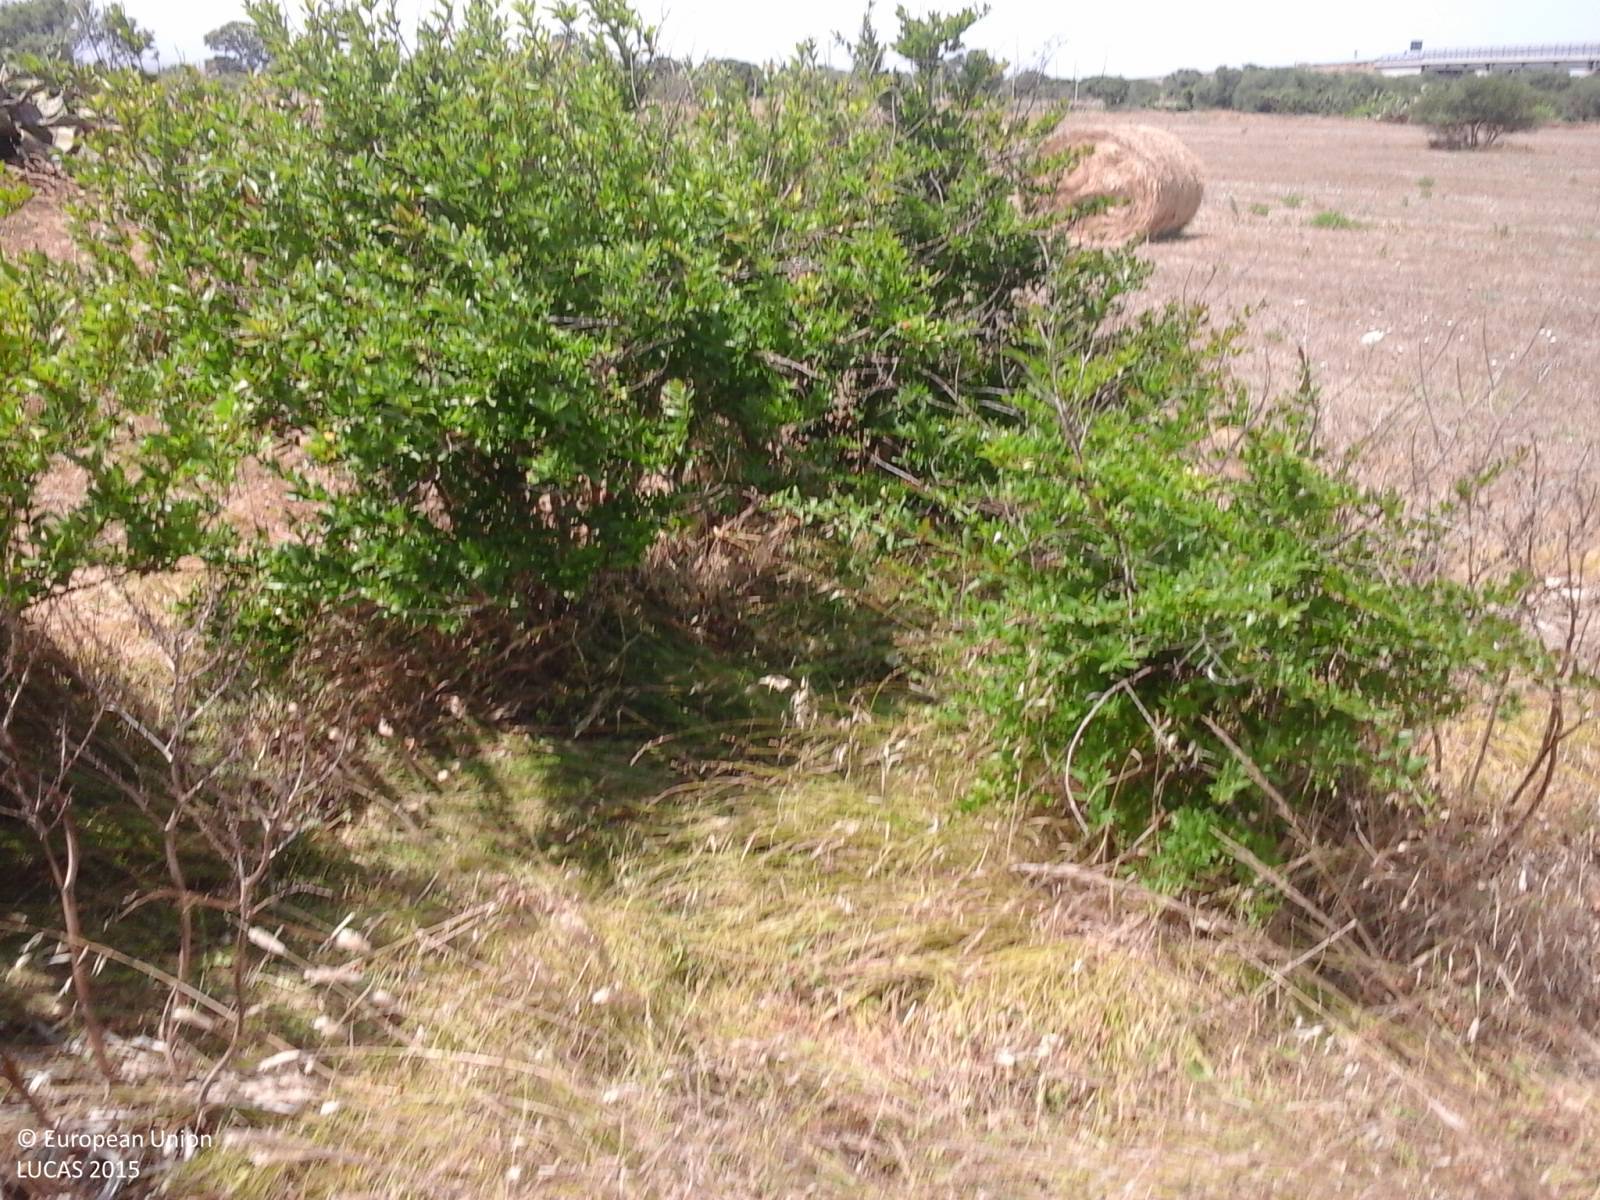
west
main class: Cropland
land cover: Apple fruit
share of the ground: 10 - 25 %
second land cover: Grassland without tree/shrub cover
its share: > 75 %
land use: Agriculture (excluding fallow land and kitchen gardens)
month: July
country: IT
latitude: 39.5538
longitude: 8.8083
